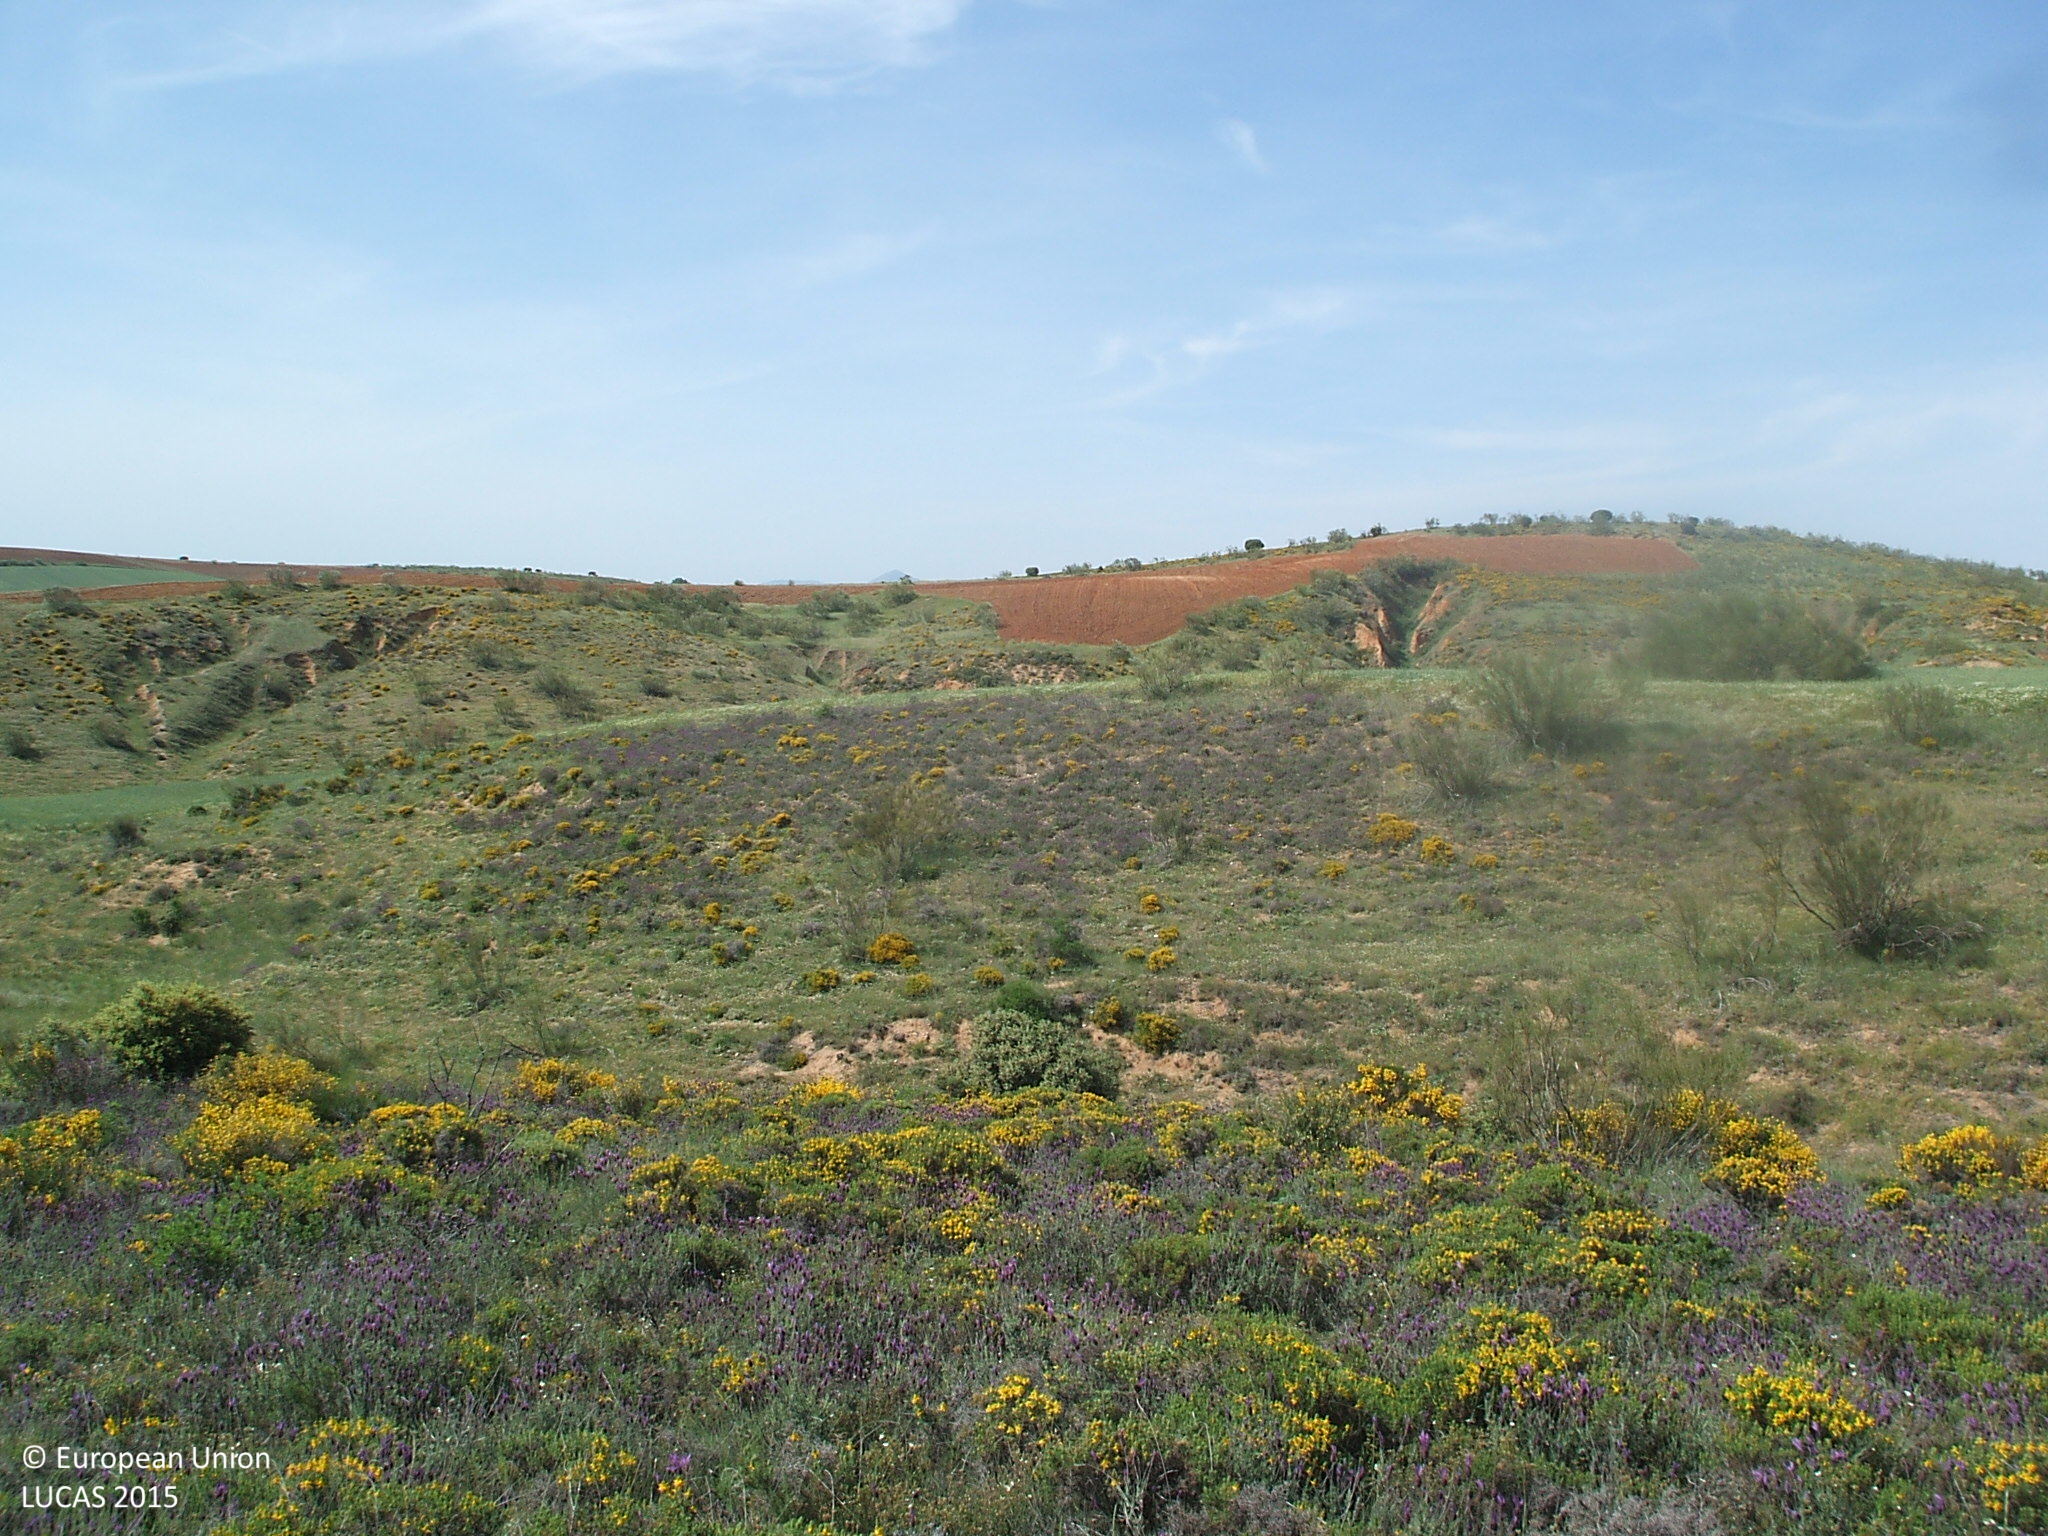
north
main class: Shrubland
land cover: Shrubland without tree cover
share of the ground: > 75 %
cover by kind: shrubs 90 %, herbaceous plants 10 %
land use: Semi-natural and natural areas not in use
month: May
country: ES
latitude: 40.7372
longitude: -3.3828
